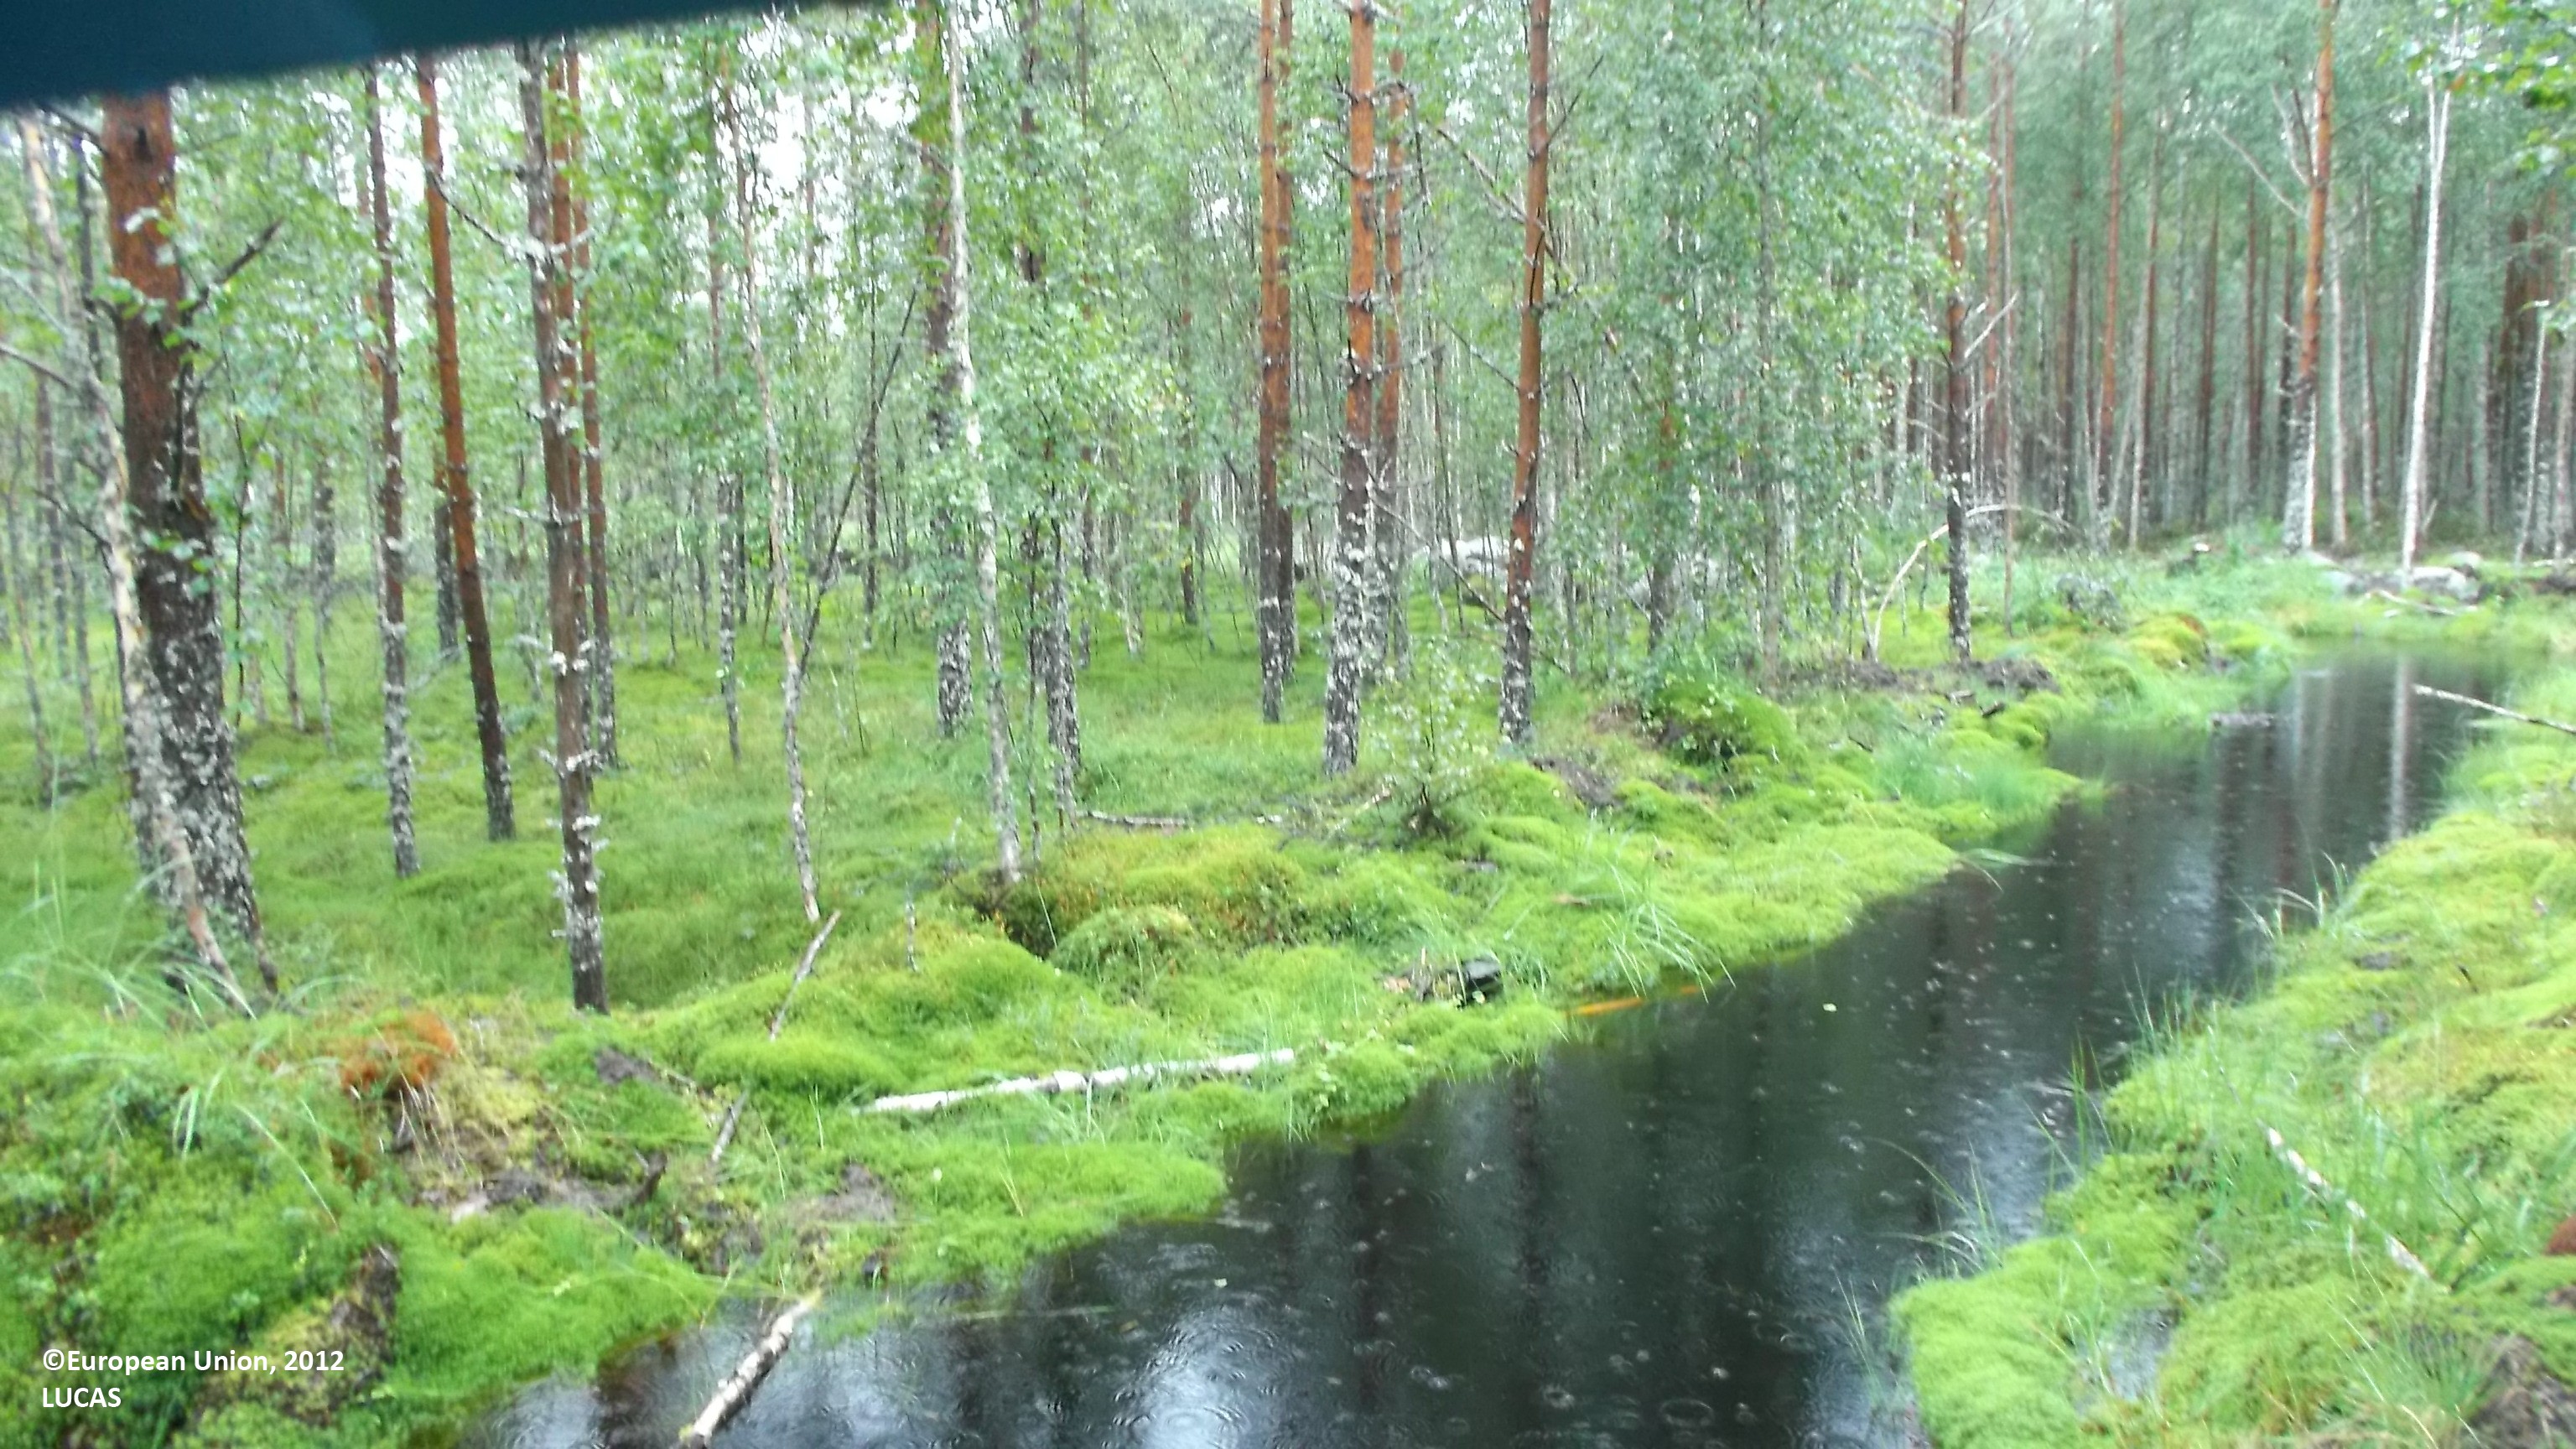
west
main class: Woodland
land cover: Other mixed woodland
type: mire and swamp forests
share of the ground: 50 - 75 %
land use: Forestry
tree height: > 5 m
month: August
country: FI
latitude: 63.3281
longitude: 24.4374
